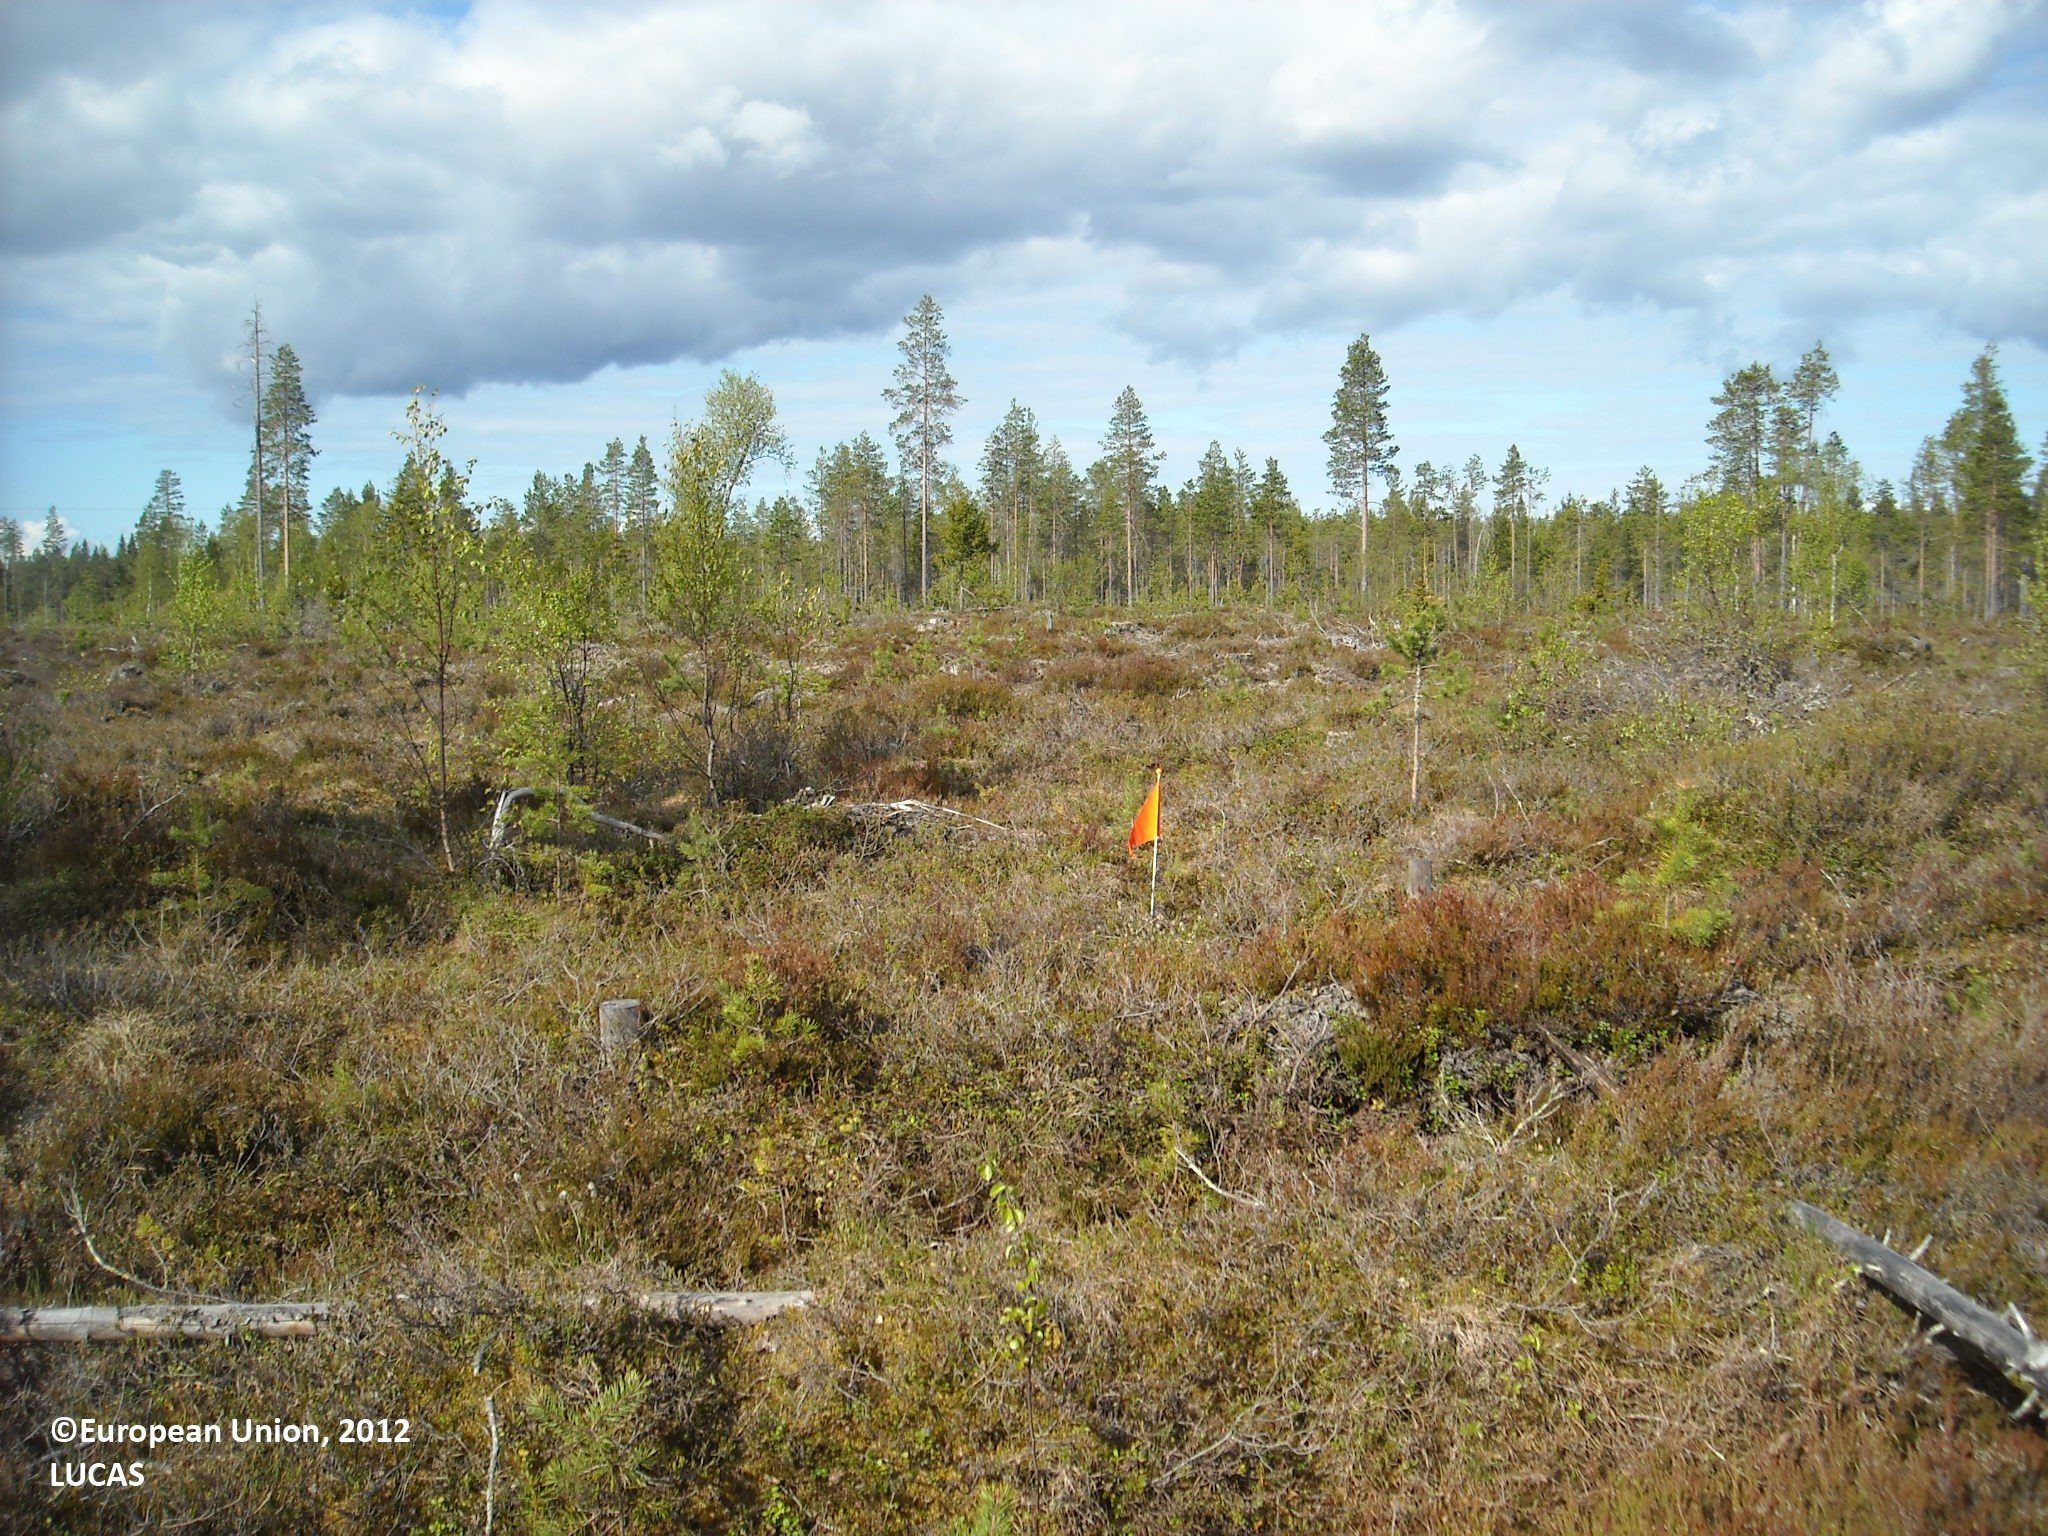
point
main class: Shrubland
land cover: Shrubland with sparse tree cover
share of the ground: > 75 %
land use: Forestry
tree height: < 5 m
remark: Clear cut
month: May
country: FI
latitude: 64.7565
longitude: 27.3035
